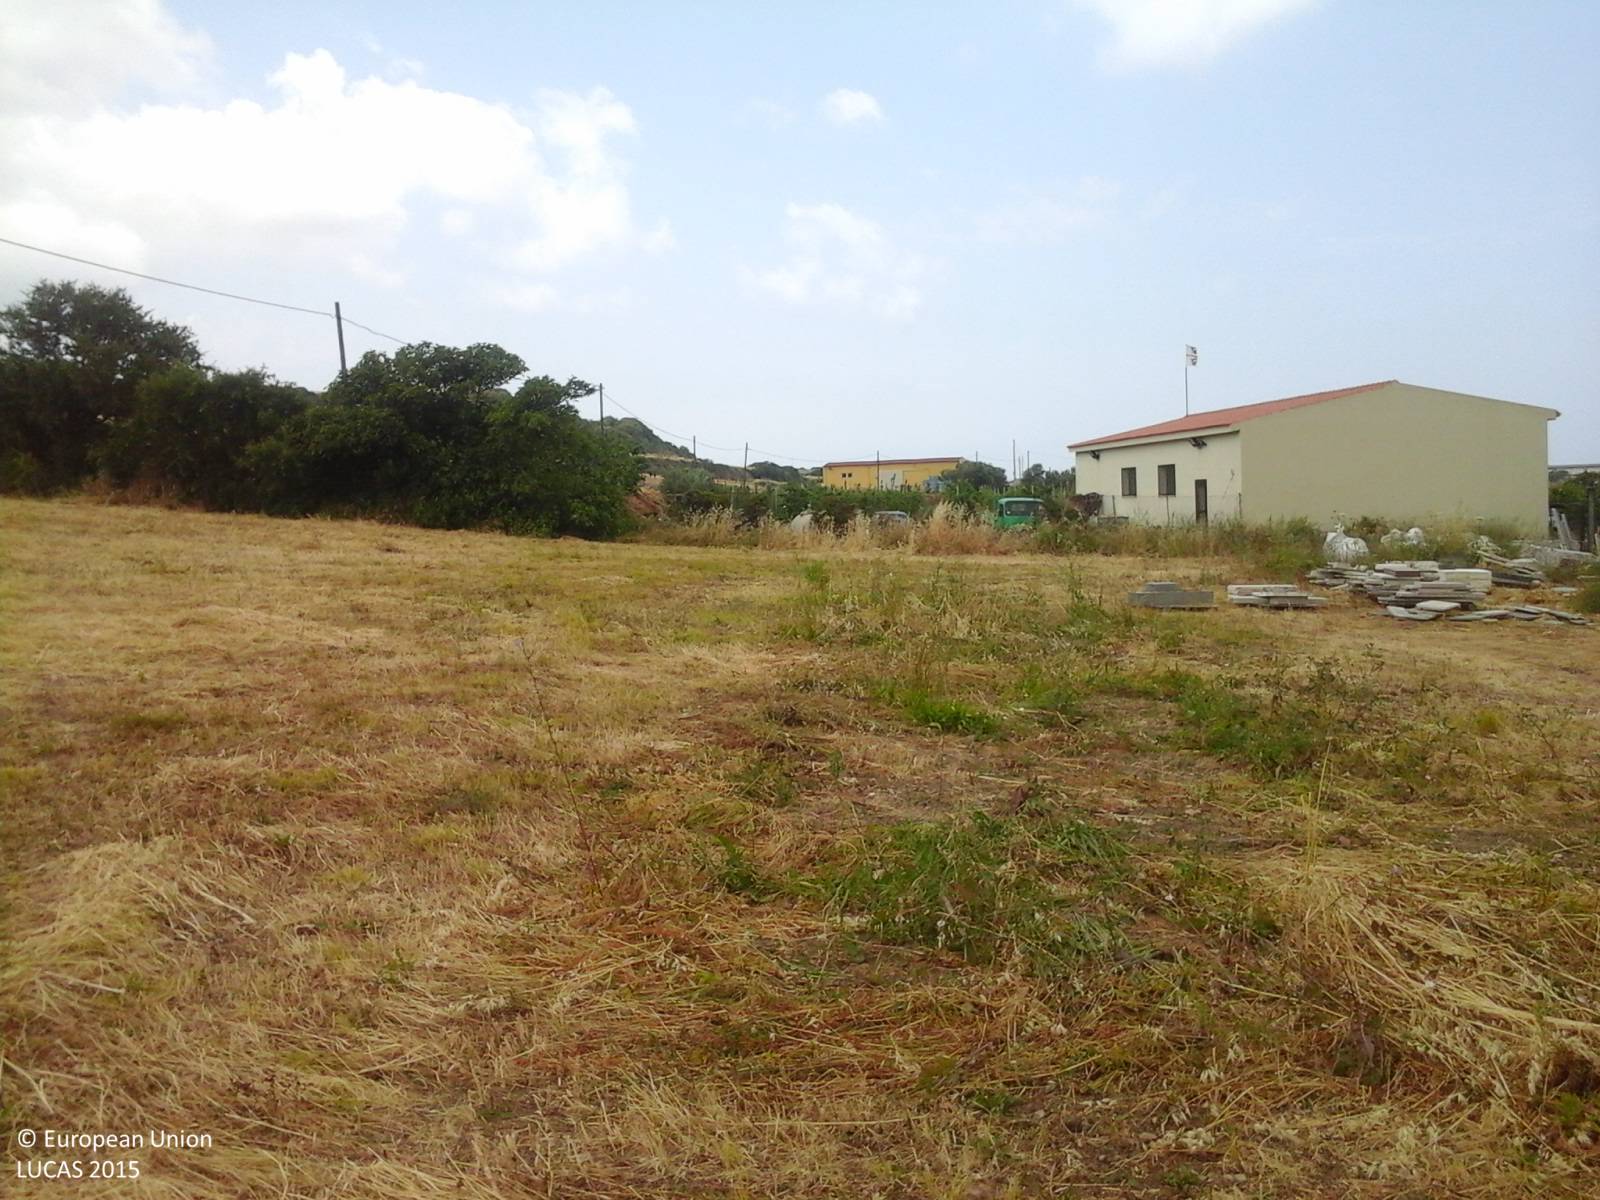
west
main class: Grassland
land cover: Grassland without tree/shrub cover
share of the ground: > 75 %
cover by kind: herbaceous plants 95 %, shrubs 5 %
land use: Semi-natural and natural areas not in use
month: May
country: IT
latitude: 40.9122
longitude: 8.8537
